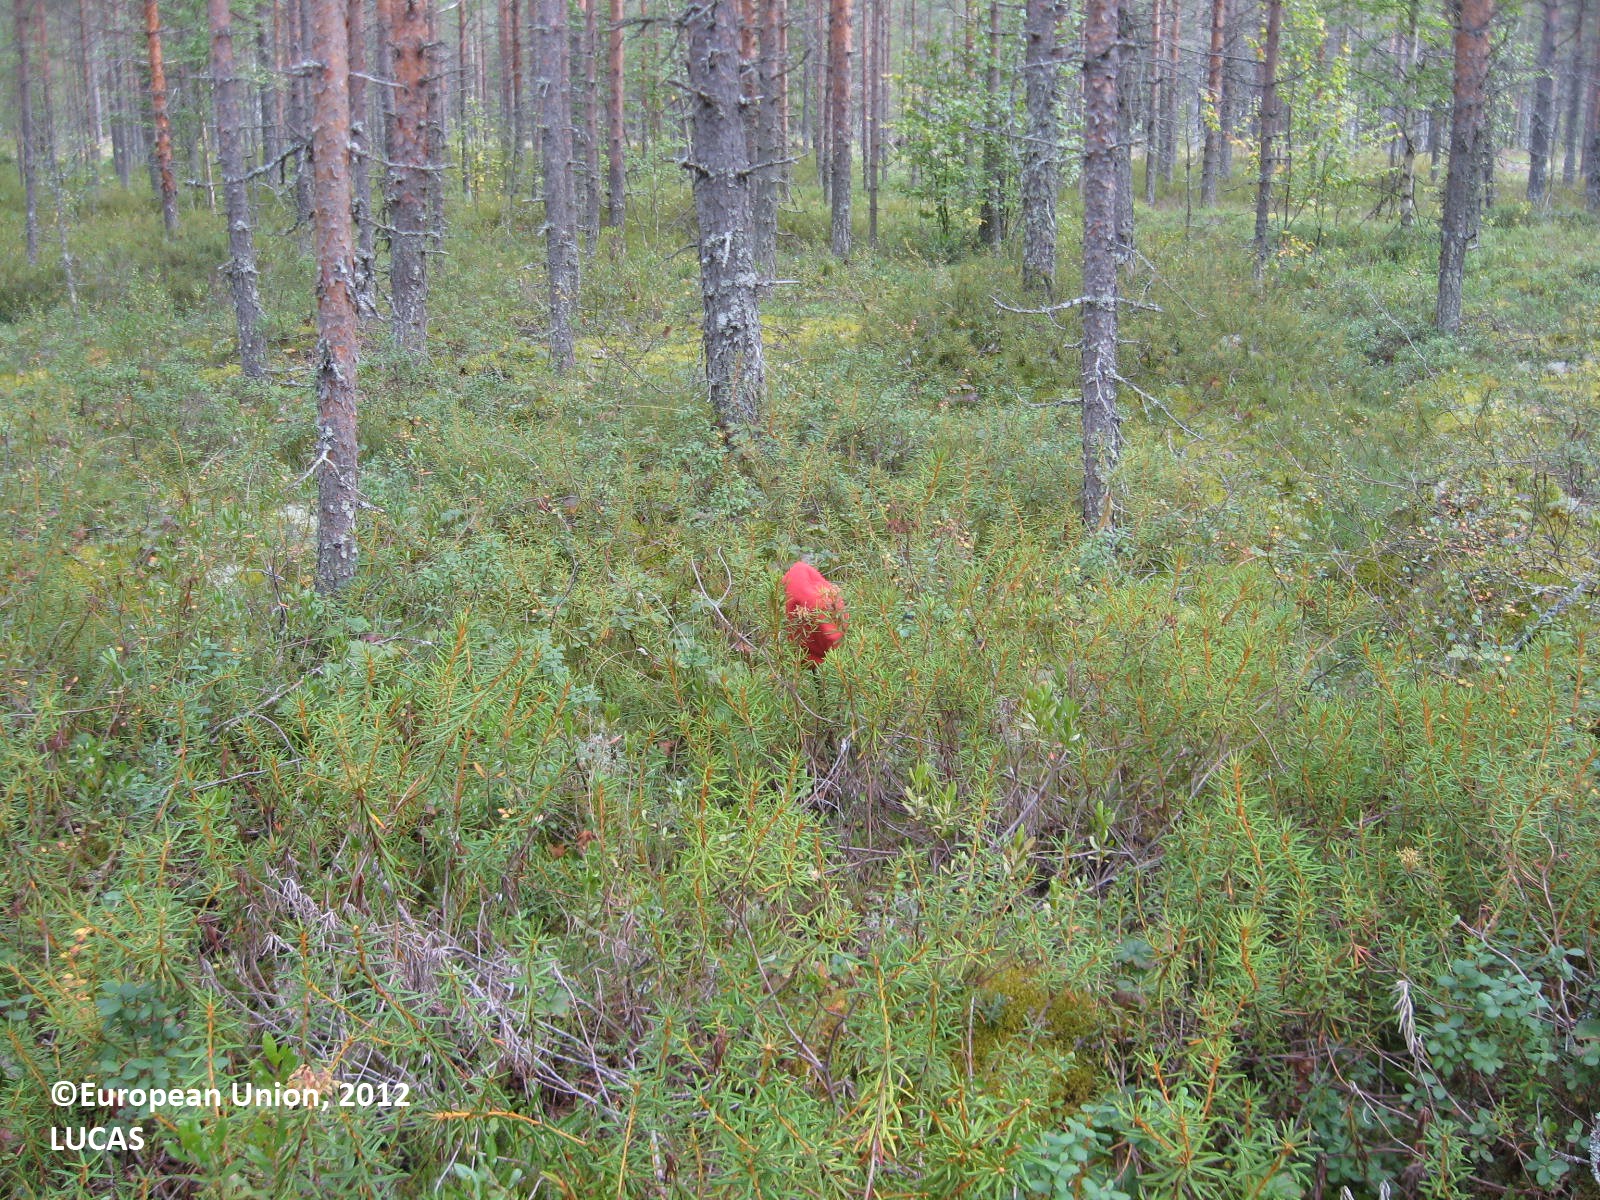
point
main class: Woodland
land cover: Pine dominated coniferous woodland
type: boreal forest
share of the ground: > 75 %
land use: Forestry
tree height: > 5 m
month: August
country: FI
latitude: 63.4472
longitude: 30.0824
